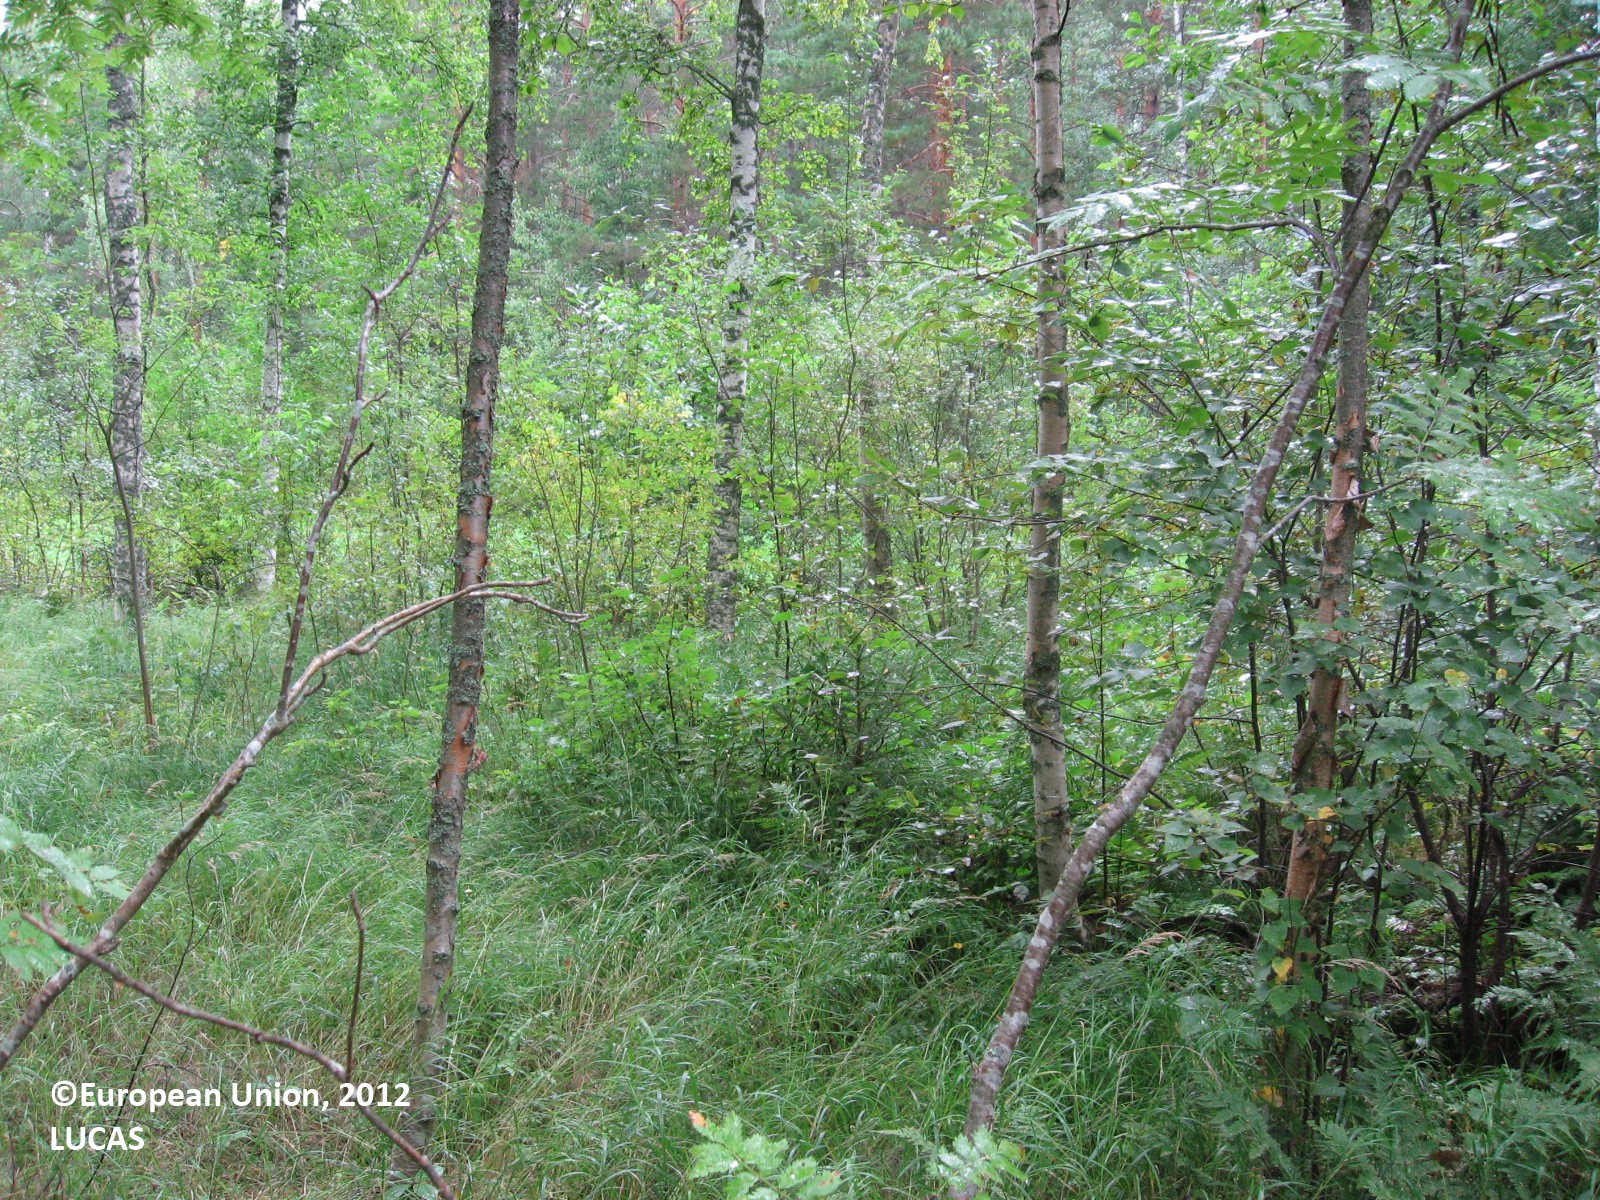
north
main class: Woodland
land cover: Other mixed woodland
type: boreal forest
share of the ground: 50 - 75 %
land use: Forestry
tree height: > 5 m
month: August
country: FI
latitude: 61.3298
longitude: 24.7351
